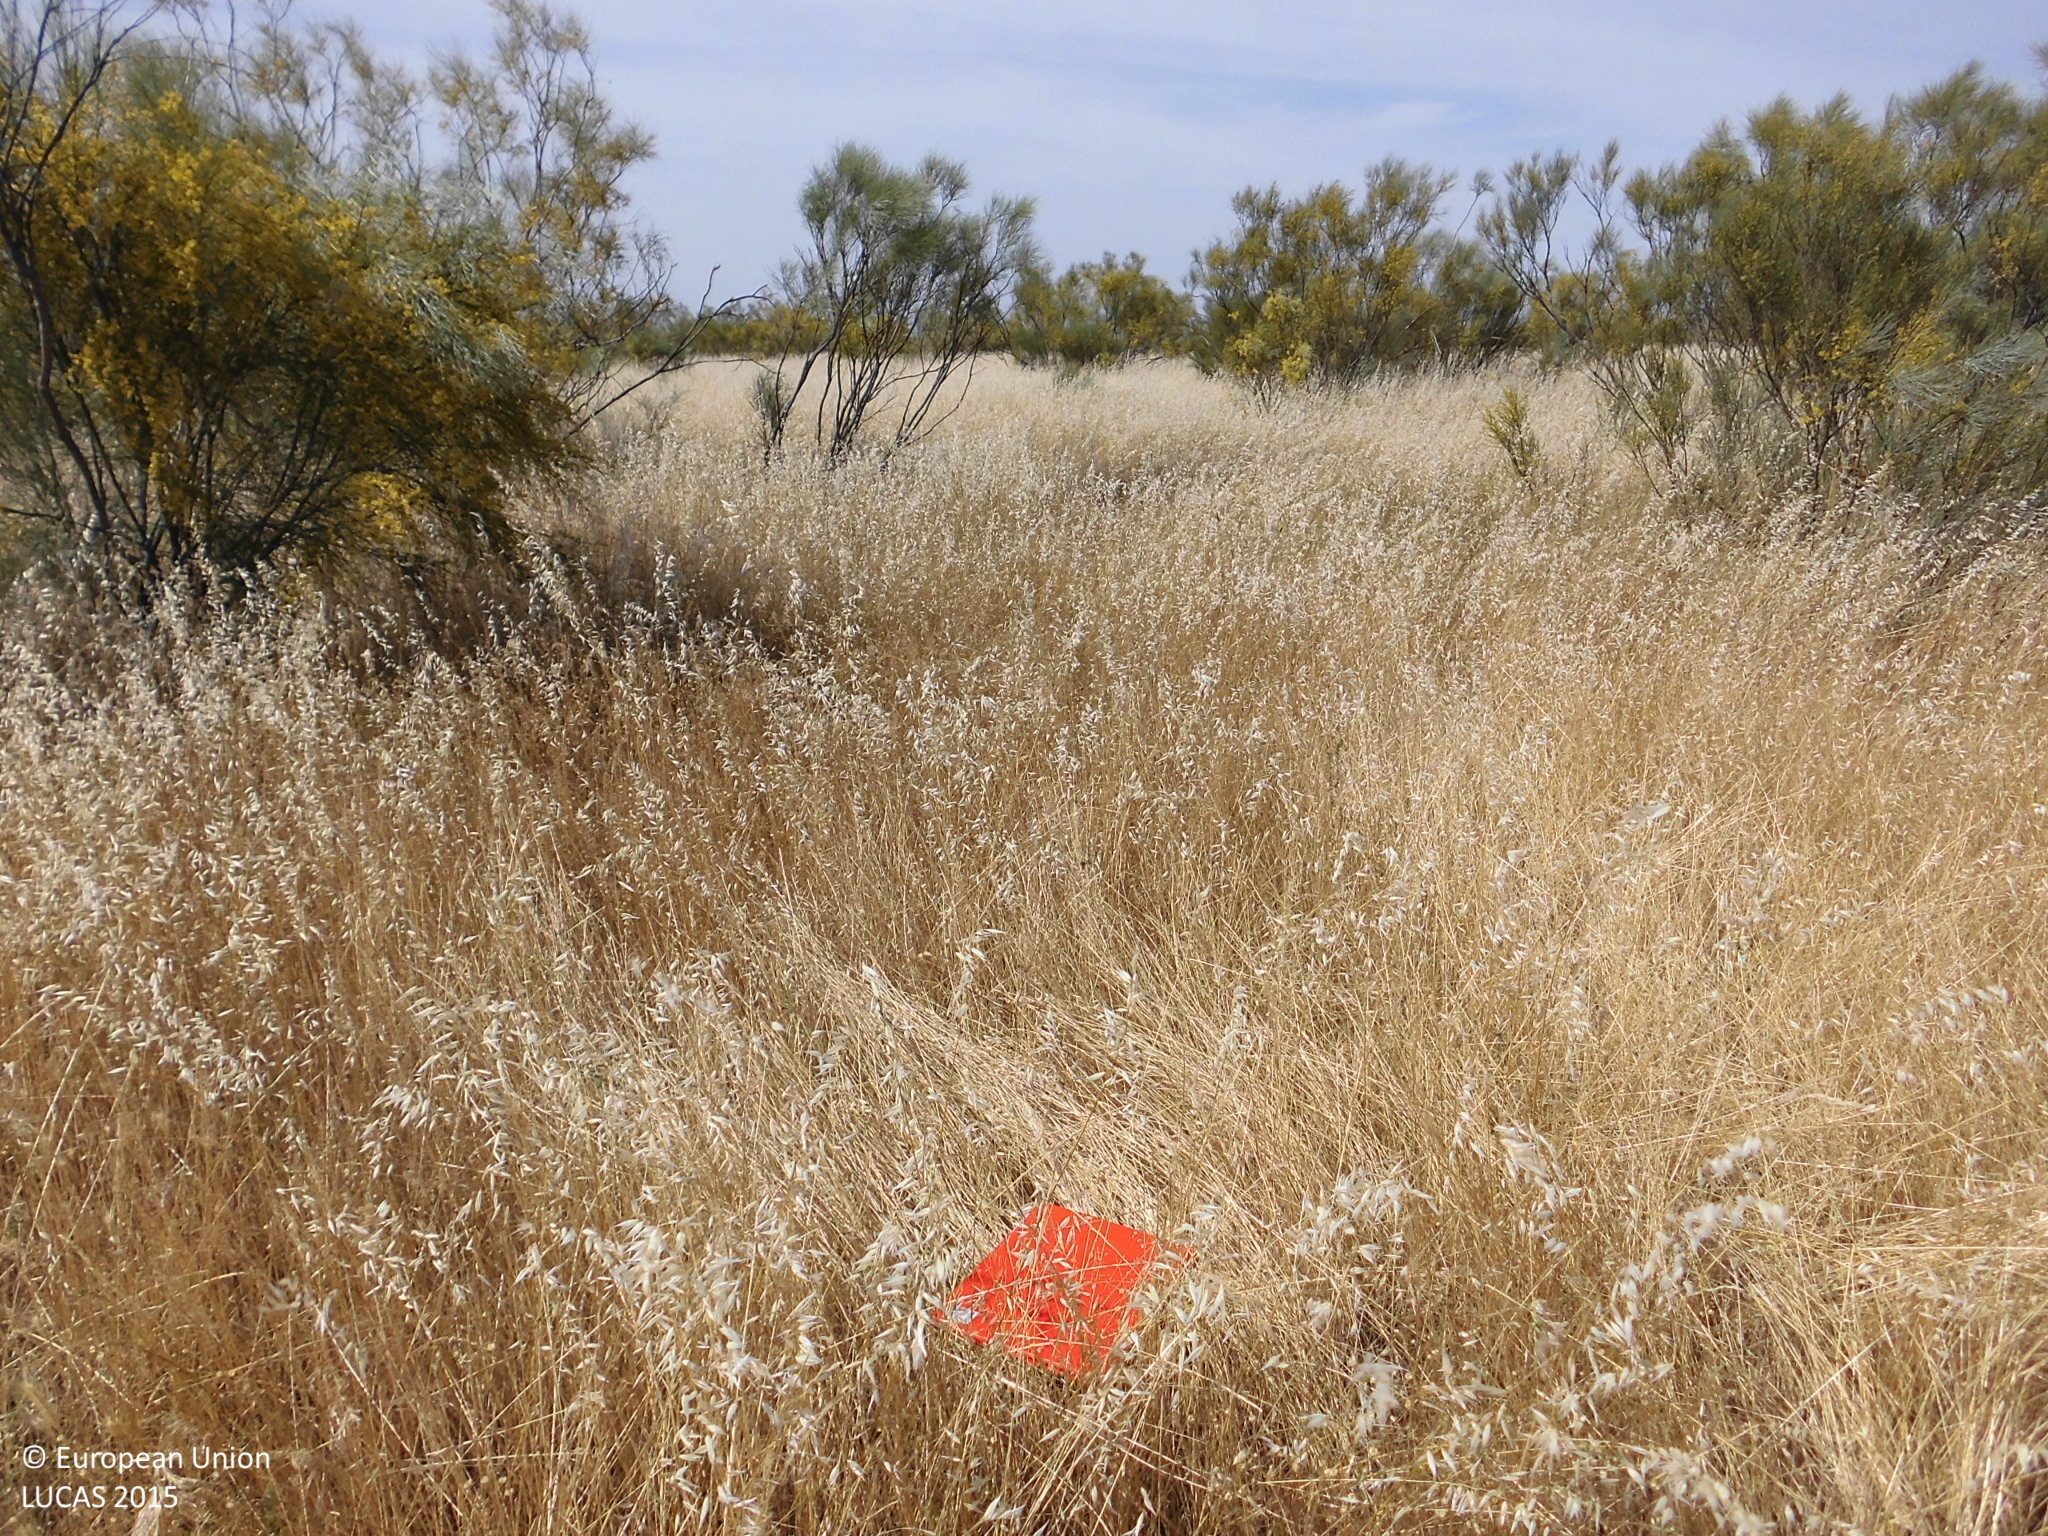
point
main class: Shrubland
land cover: Shrubland without tree cover
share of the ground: 10 - 25 %
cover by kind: herbaceous plants 85 %, shrubs 15 %
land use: Semi-natural and natural areas not in use
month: May
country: ES
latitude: 39.4608
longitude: -5.9947
